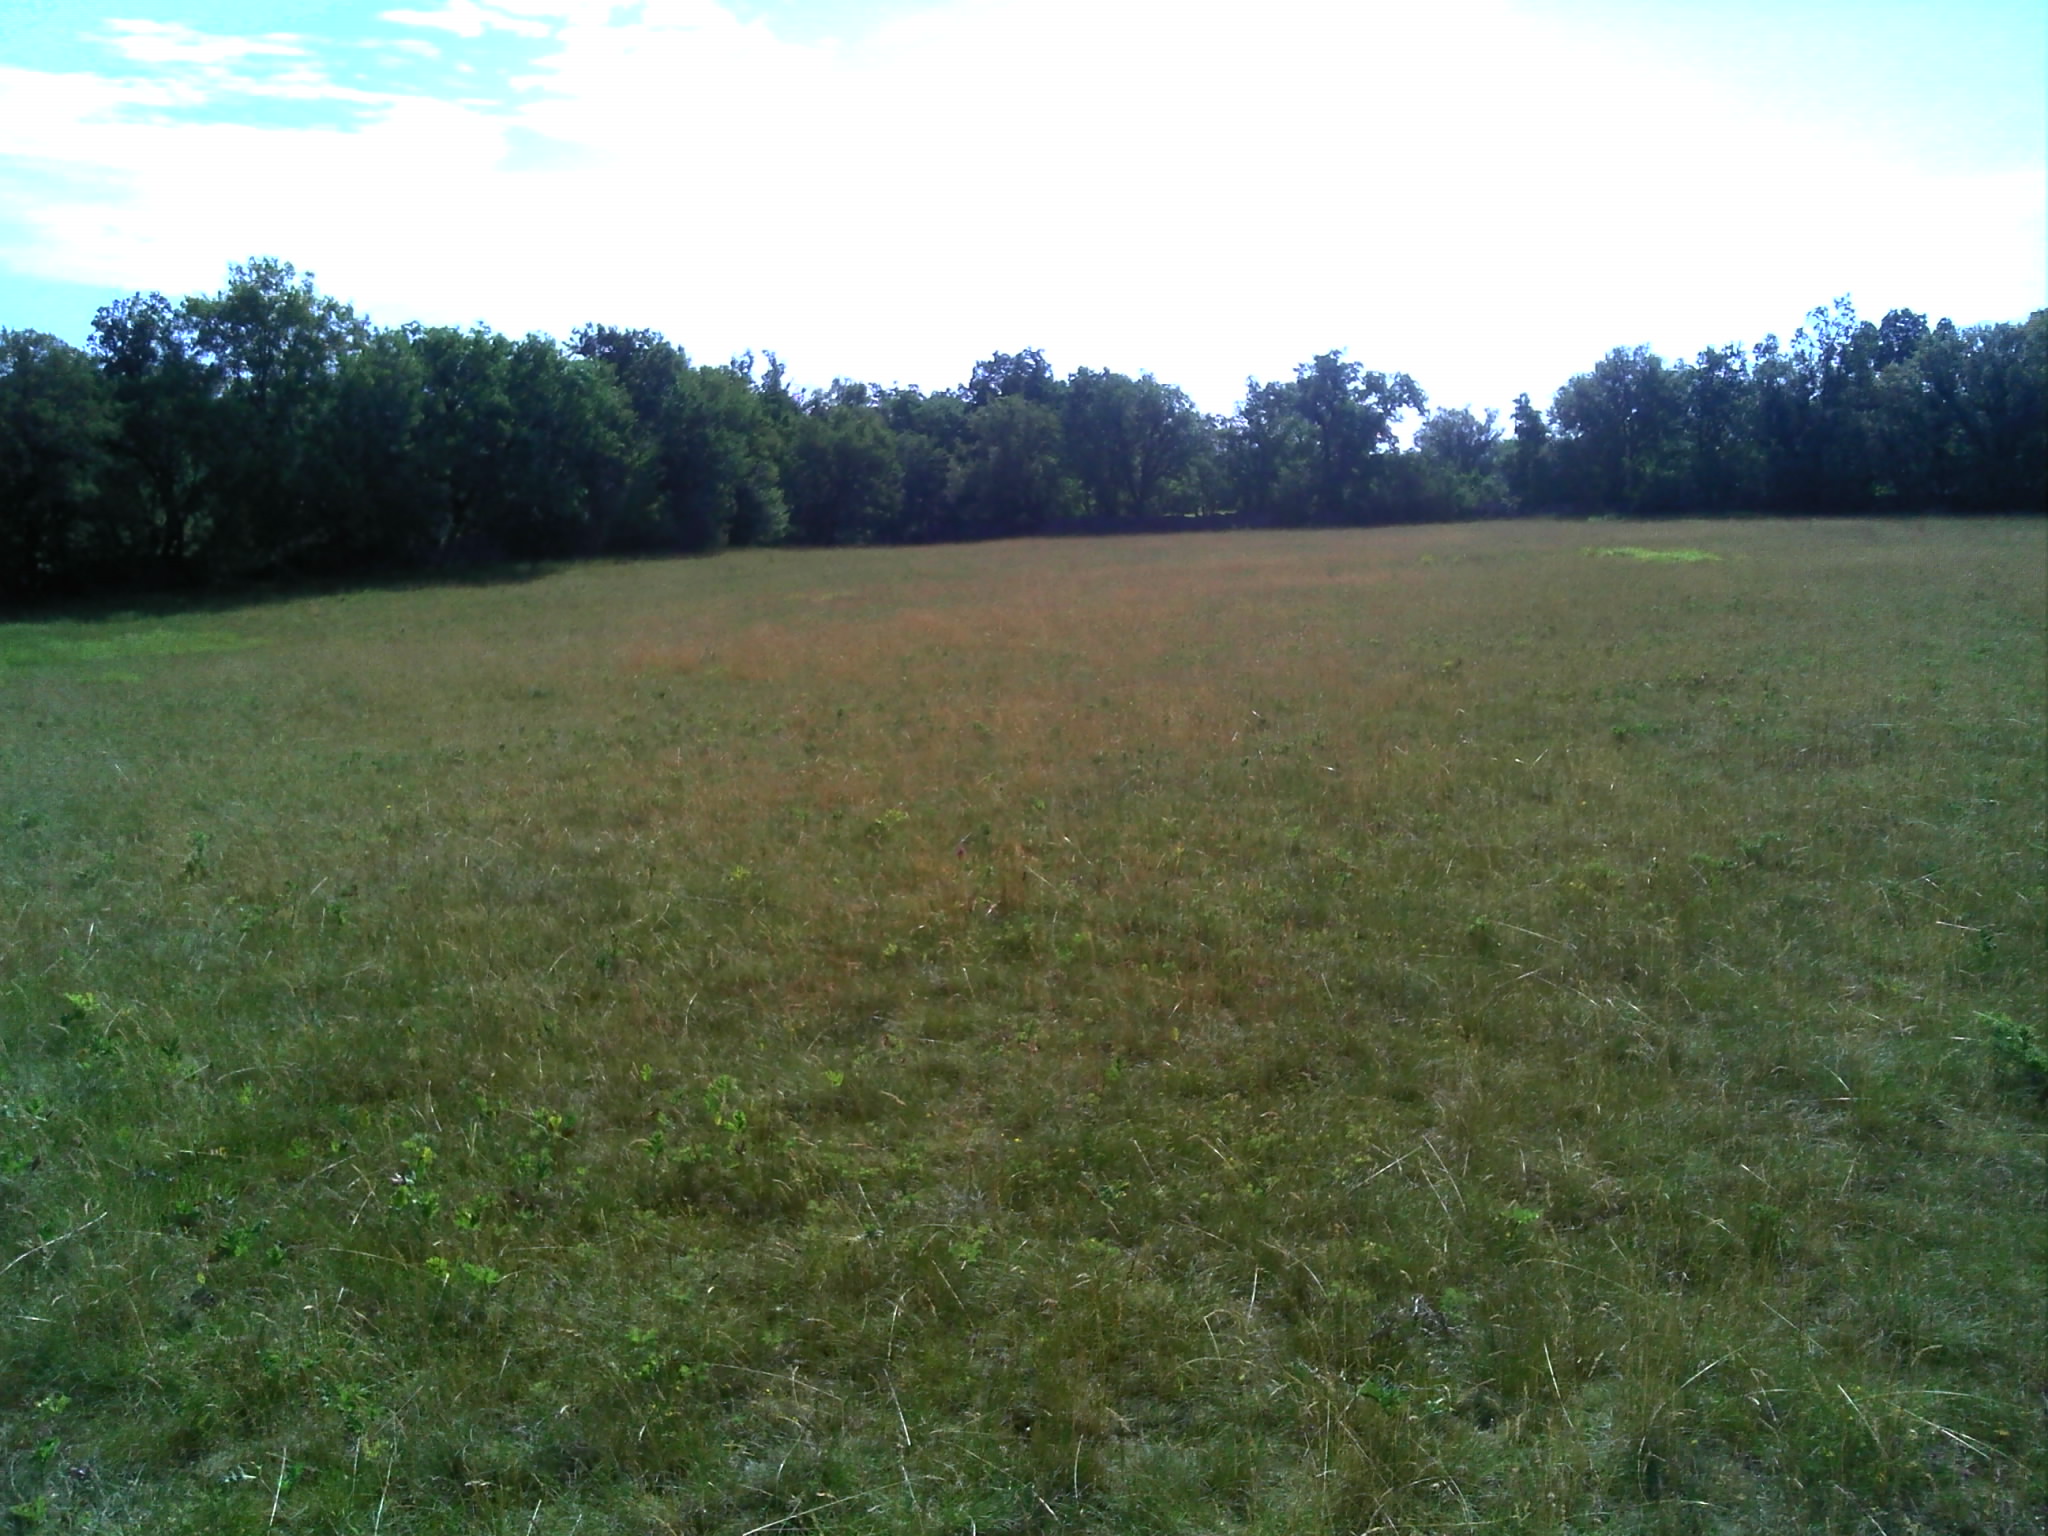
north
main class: Grassland
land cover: Grassland without tree/shrub cover
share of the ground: > 75 %
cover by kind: herbaceous plants 70 %, lichens and mosses 30 %
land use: Agriculture (excluding fallow land and kitchen gardens)
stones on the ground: 10 - 25 %
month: June
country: FR
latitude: 44.6589
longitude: 1.7889
